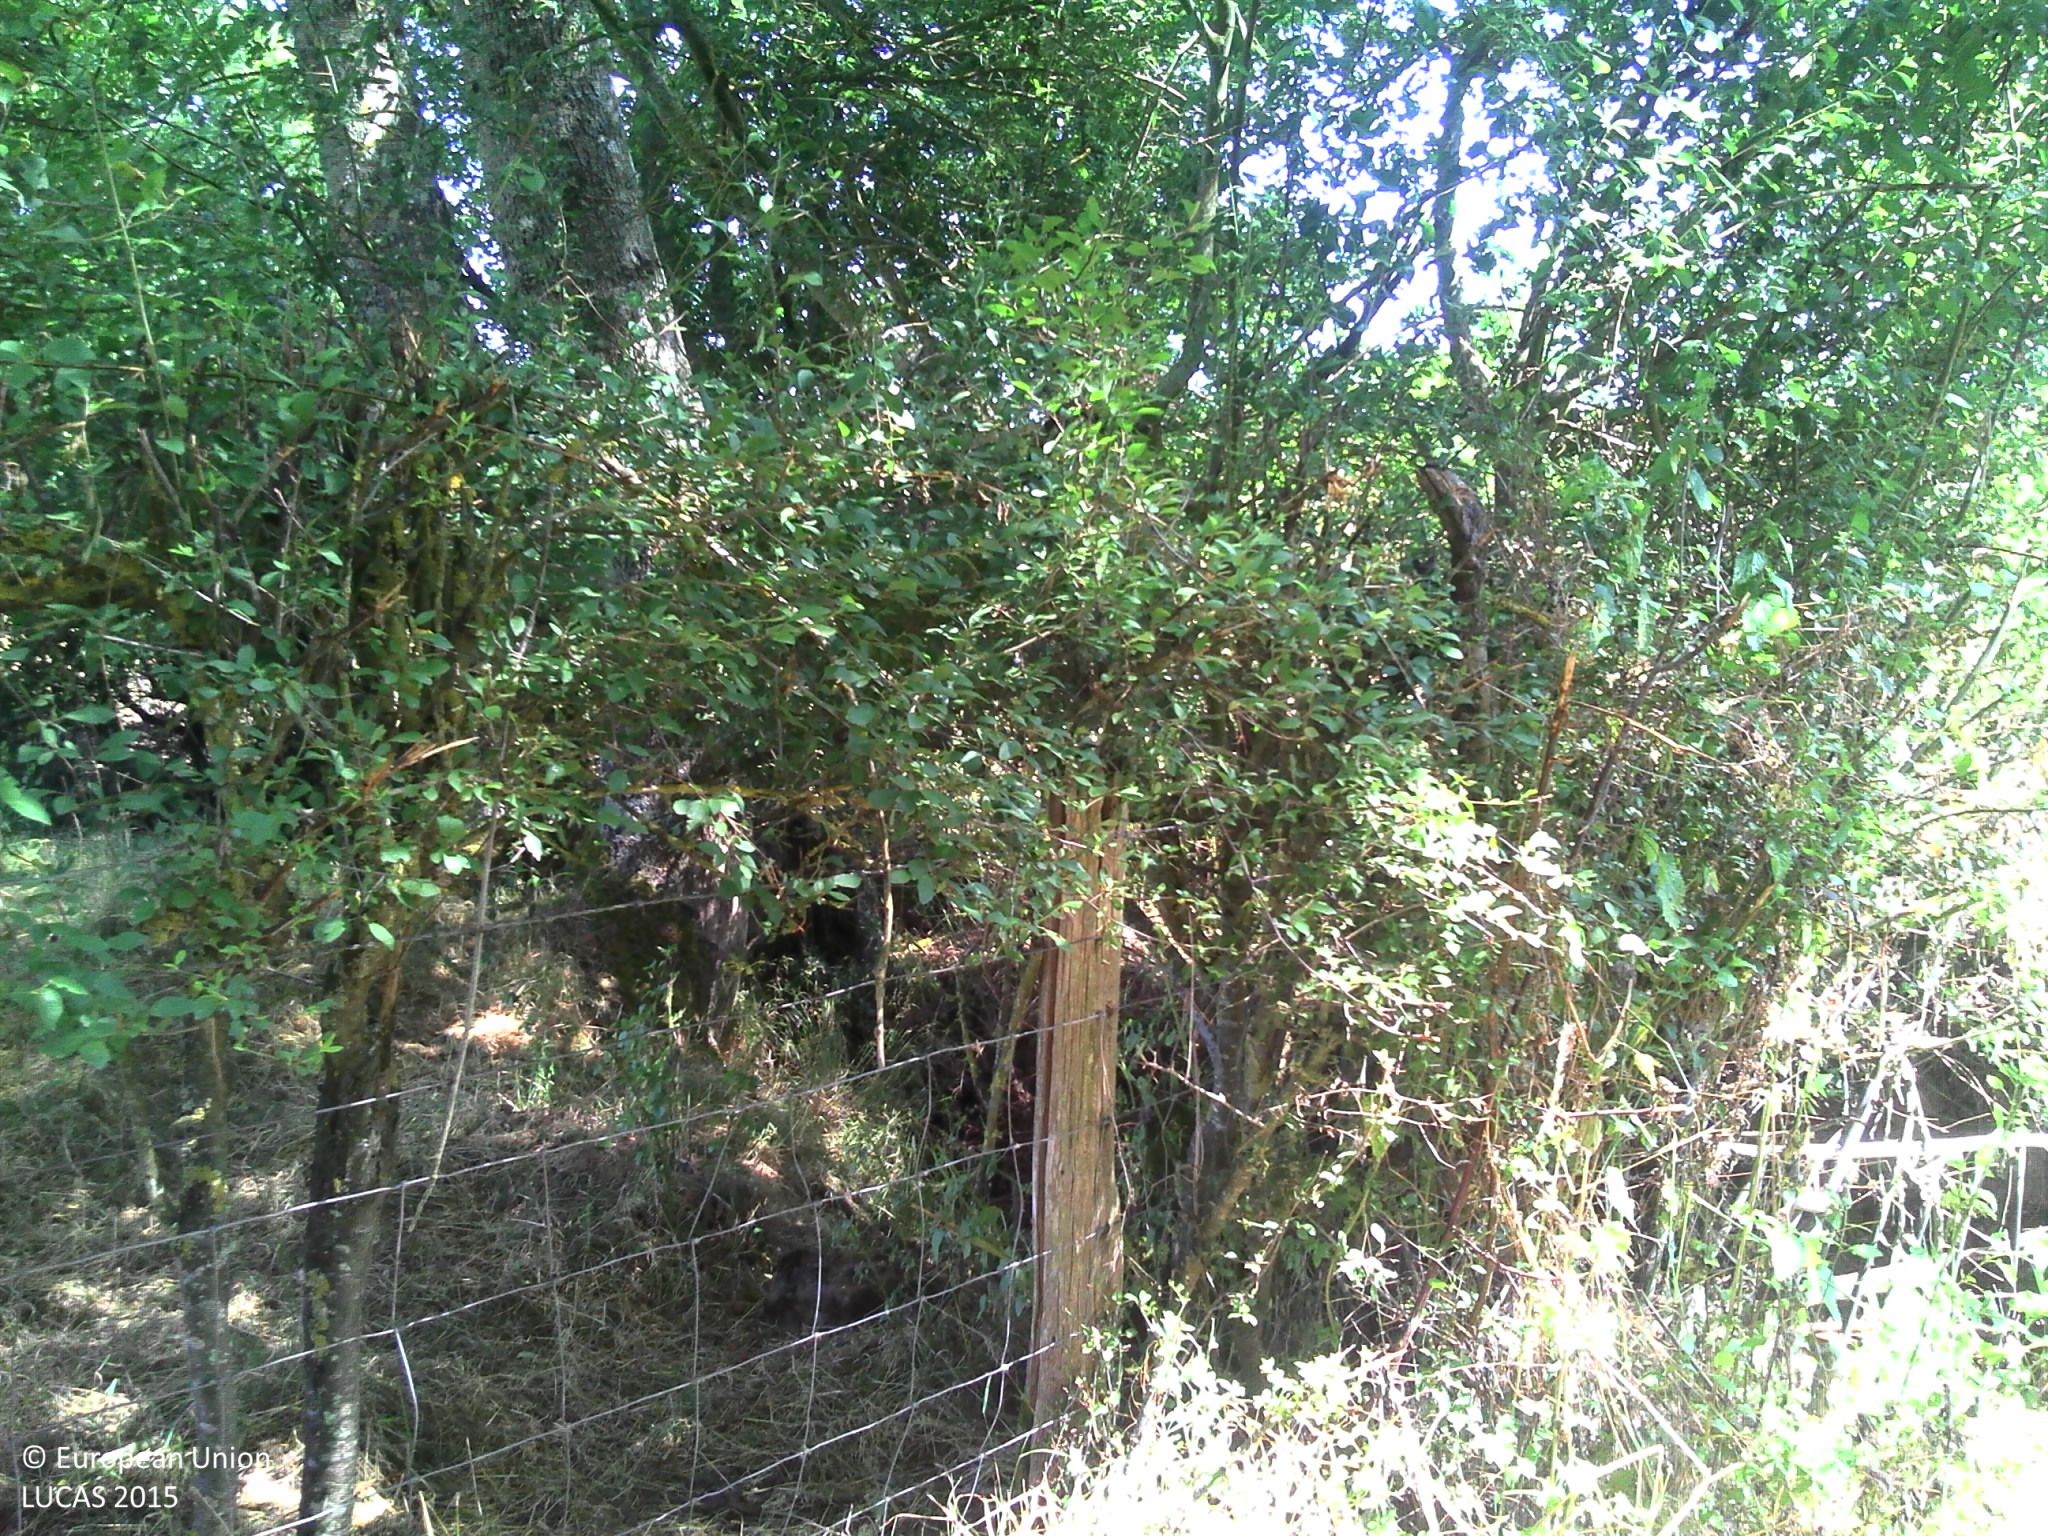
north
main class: Grassland
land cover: Grassland without tree/shrub cover
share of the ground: > 75 %
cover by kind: herbaceous plants 95 %, shrubs 5 %
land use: Agriculture (excluding fallow land and kitchen gardens)
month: July
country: FR
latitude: 46.2877
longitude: 0.8875
